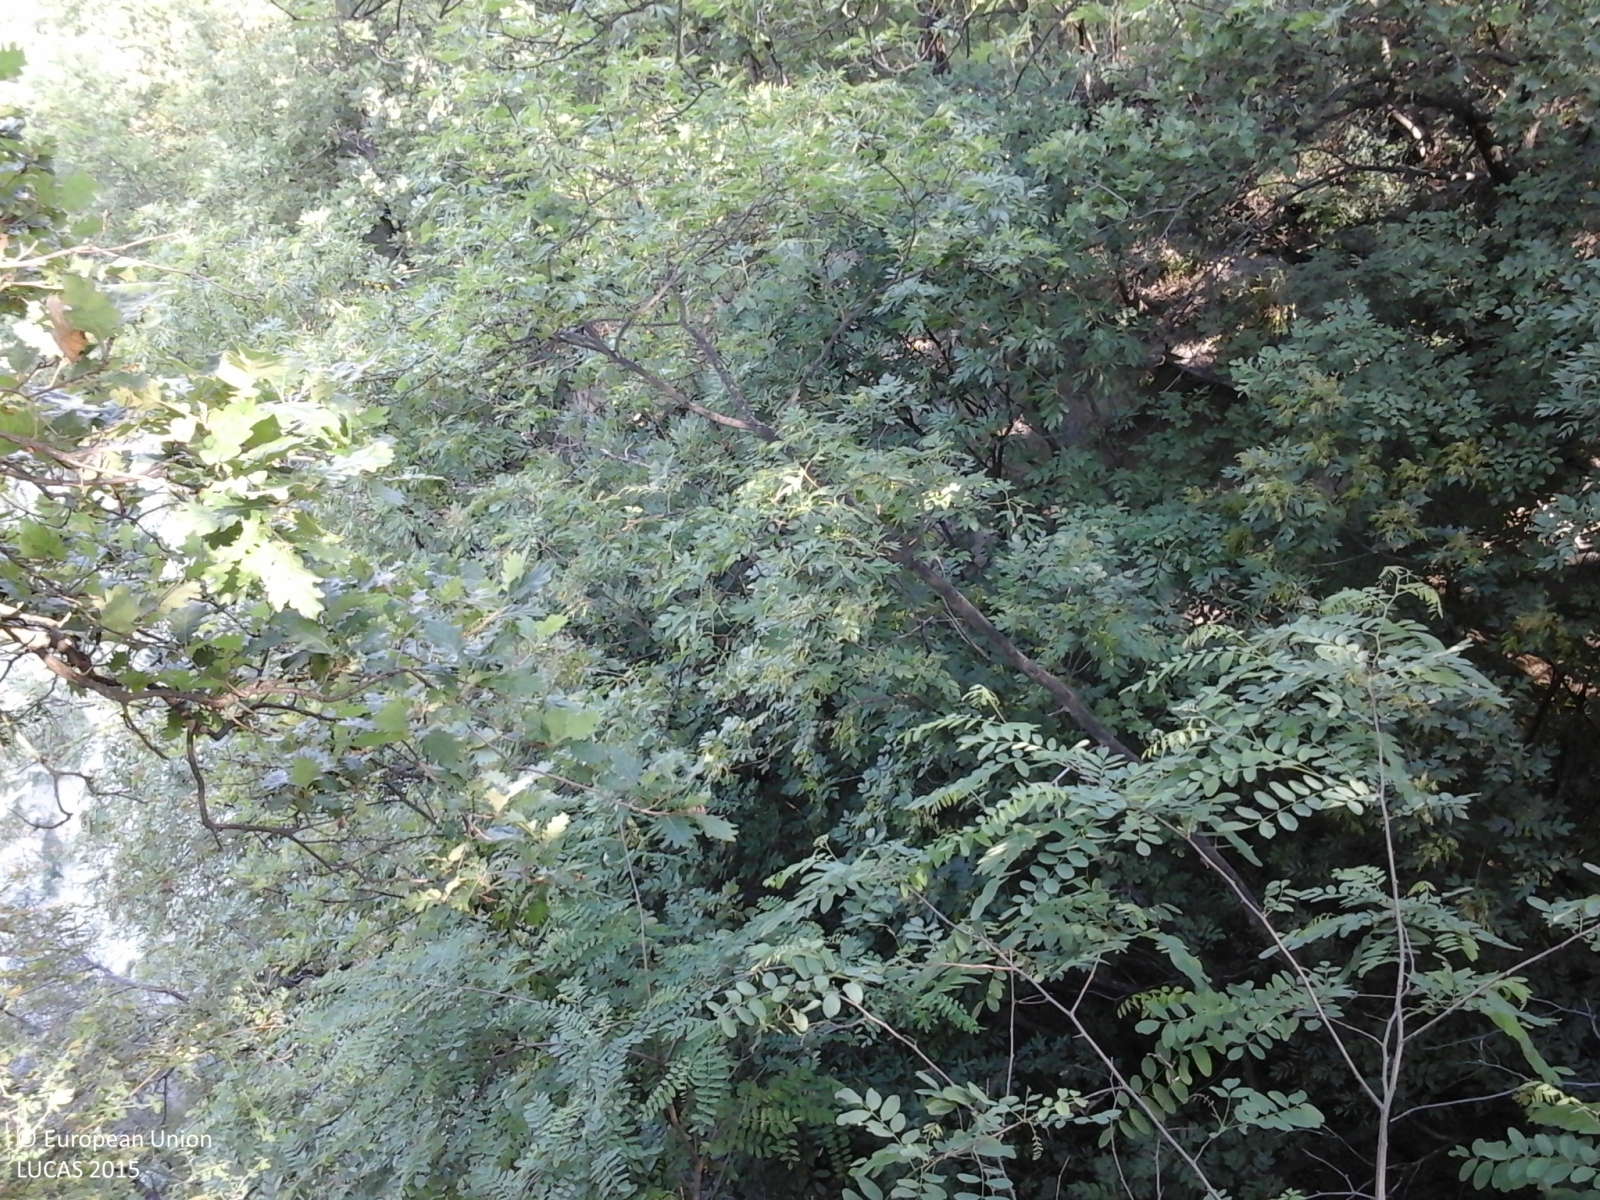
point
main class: Woodland
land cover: Broadleaved woodland
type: mesophytic deciduous forest
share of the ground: > 75 %
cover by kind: broadleaved forest trees 95 %, shrubs 5 %
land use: Forestry
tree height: > 5 m
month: June
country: IT
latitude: 44.6974
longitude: 8.2998
